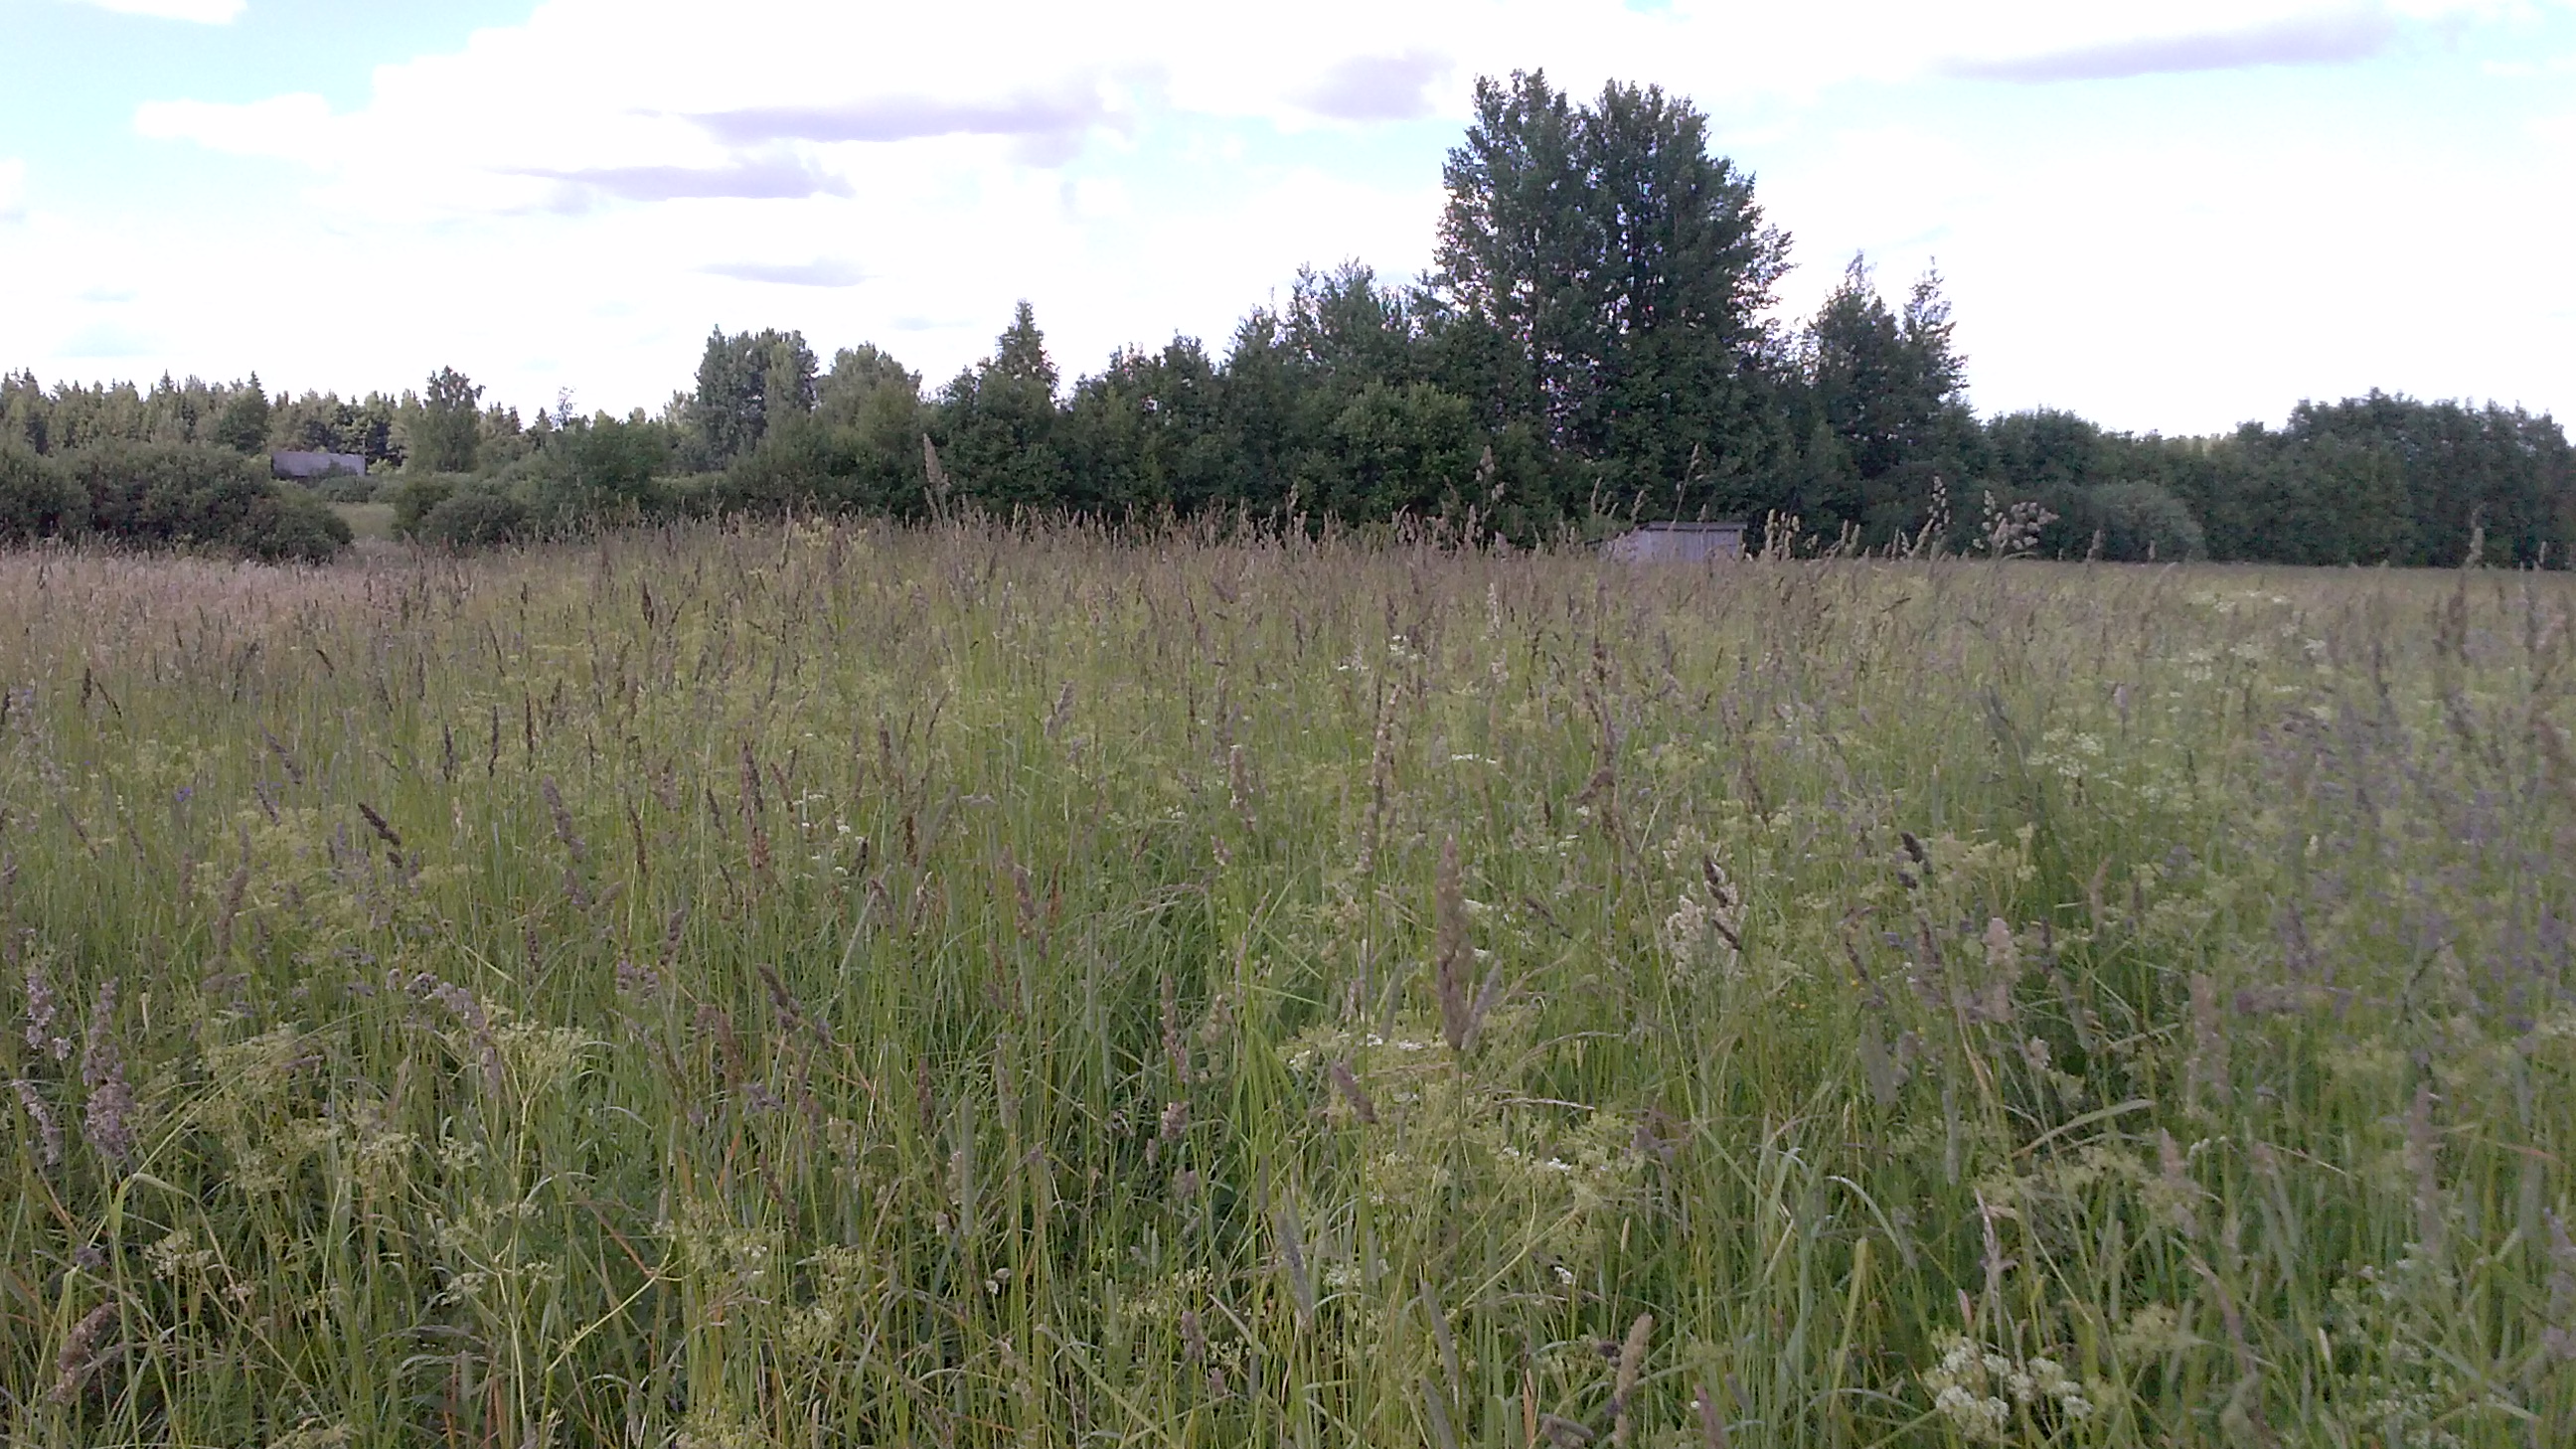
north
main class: Grassland
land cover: Grassland without tree/shrub cover
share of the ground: > 75 %
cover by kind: herbaceous plants 100 %
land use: Agriculture (excluding fallow land and kitchen gardens)
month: June
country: LV
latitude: 56.5389
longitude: 27.9022
